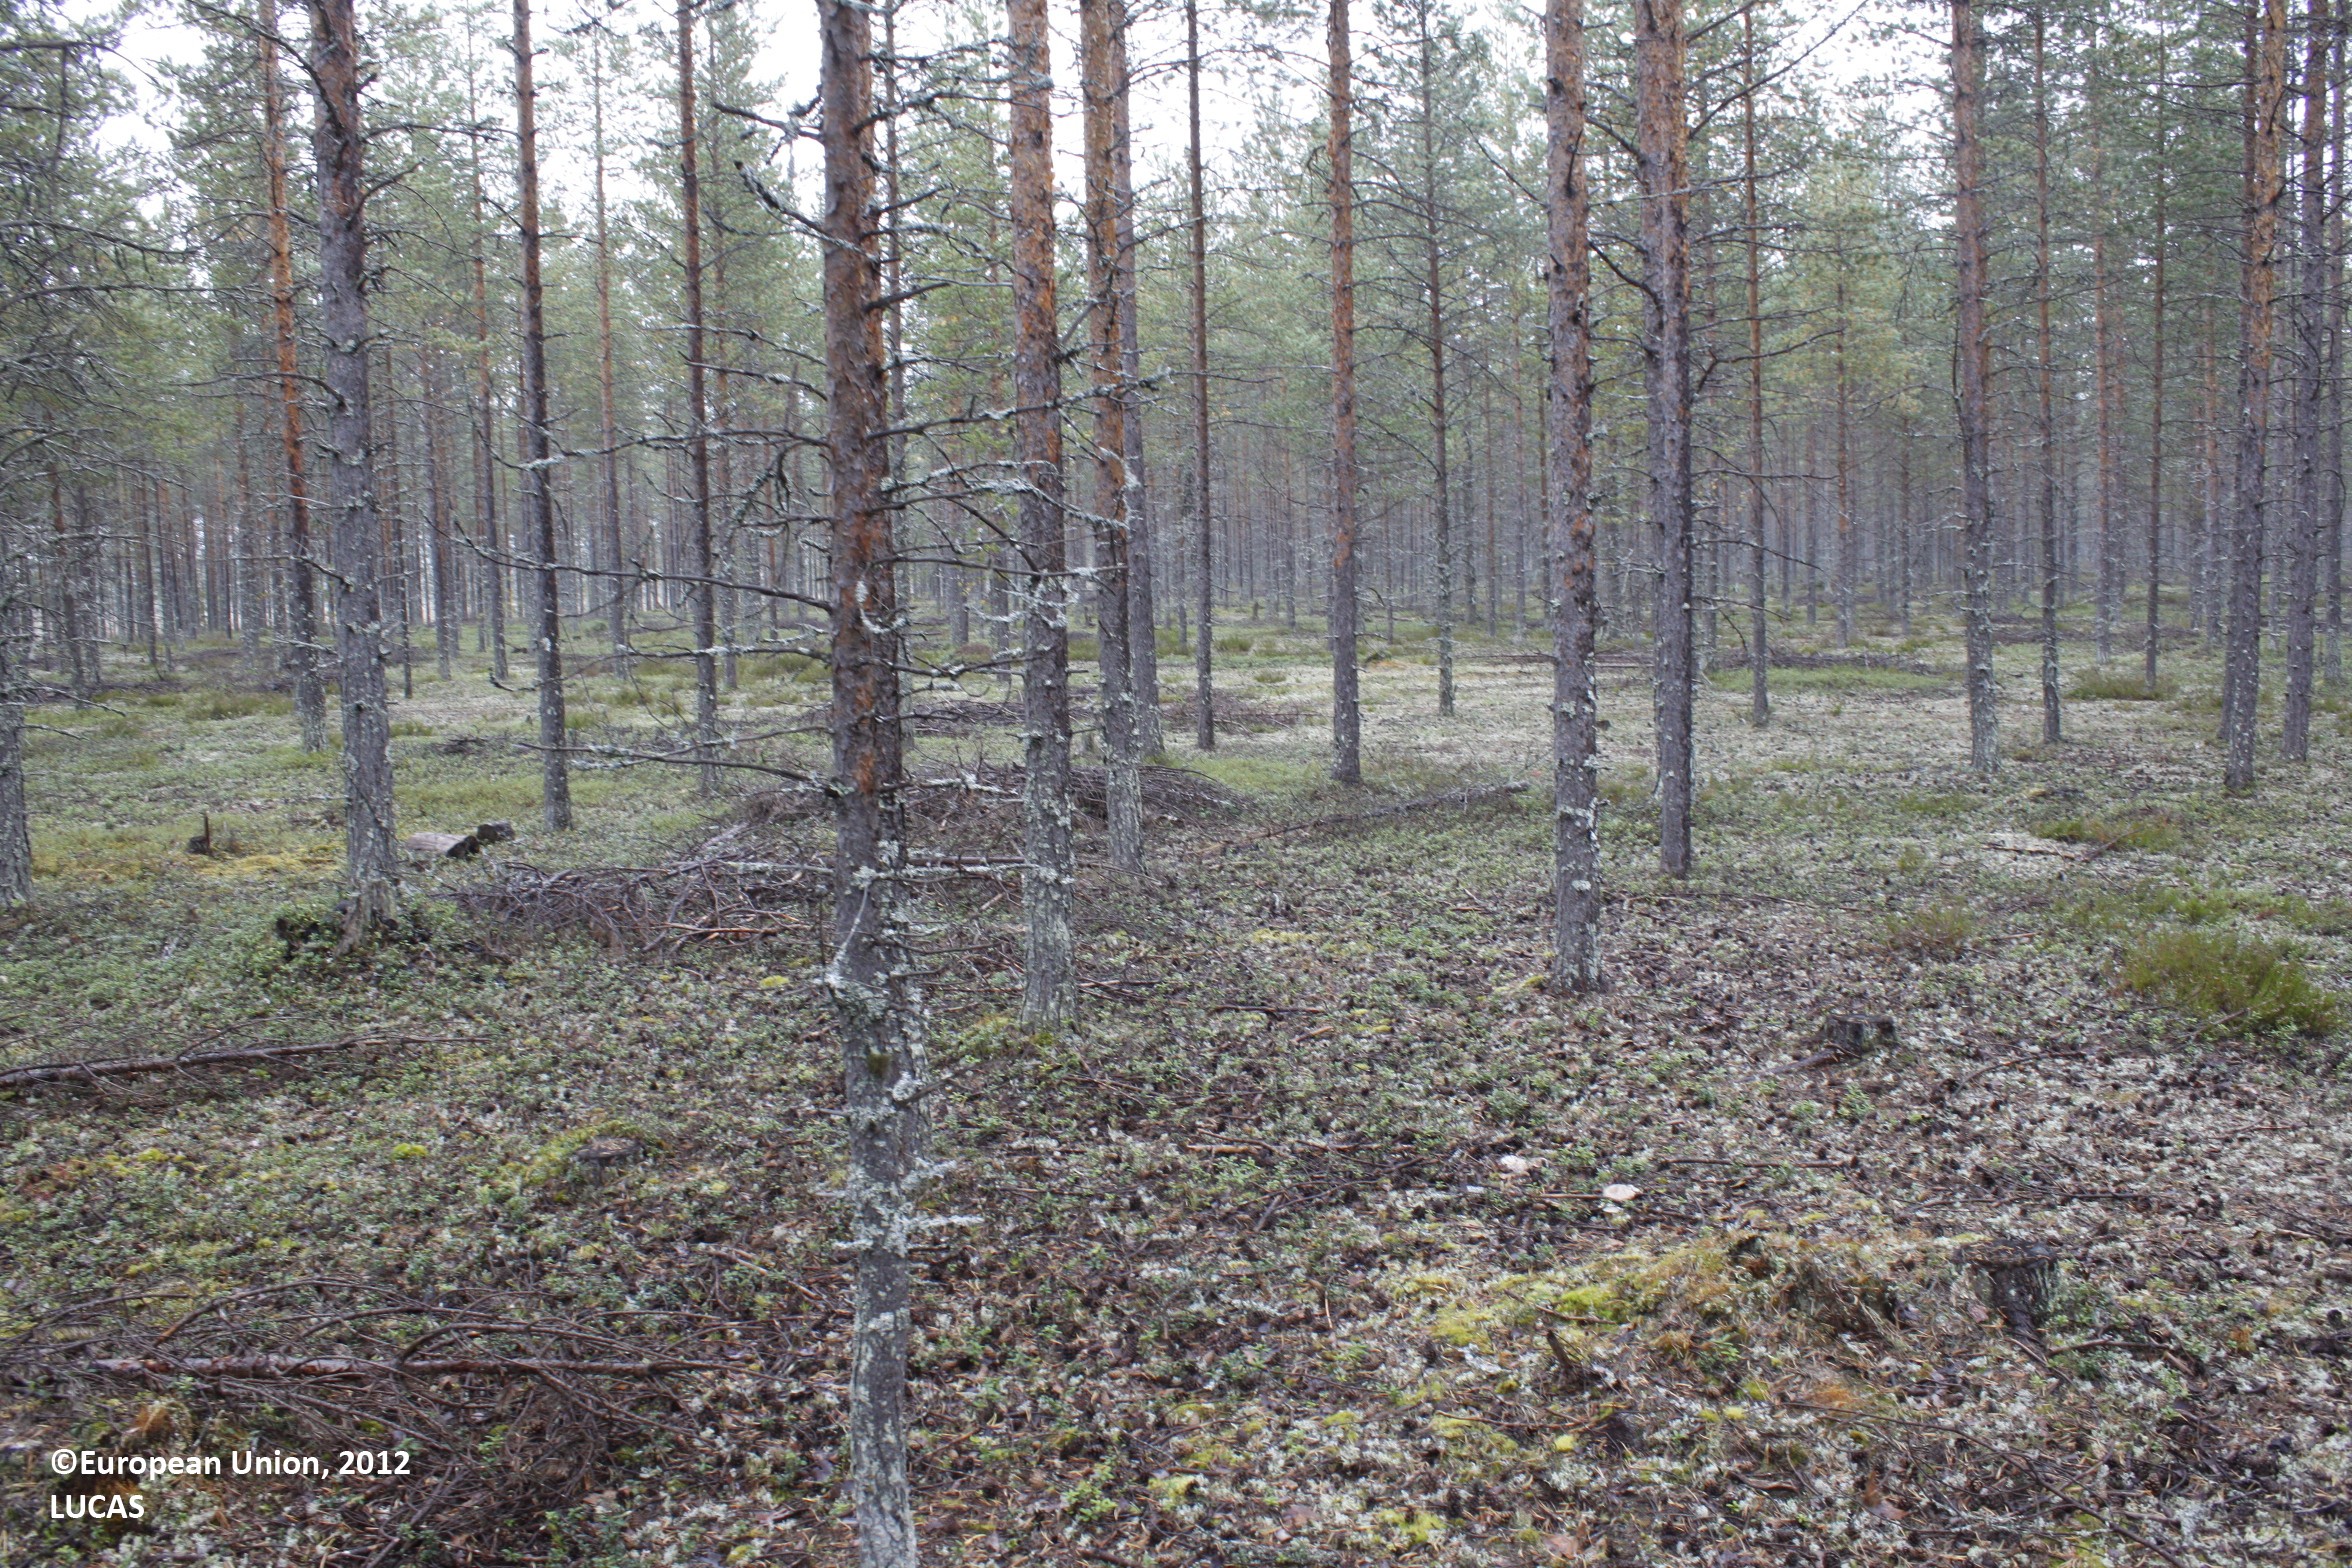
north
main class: Woodland
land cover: Pine dominated coniferous woodland
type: mire and swamp forests
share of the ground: 25 - 50 %
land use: Forestry
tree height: > 5 m
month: September
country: FI
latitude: 65.3928
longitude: 26.9237
